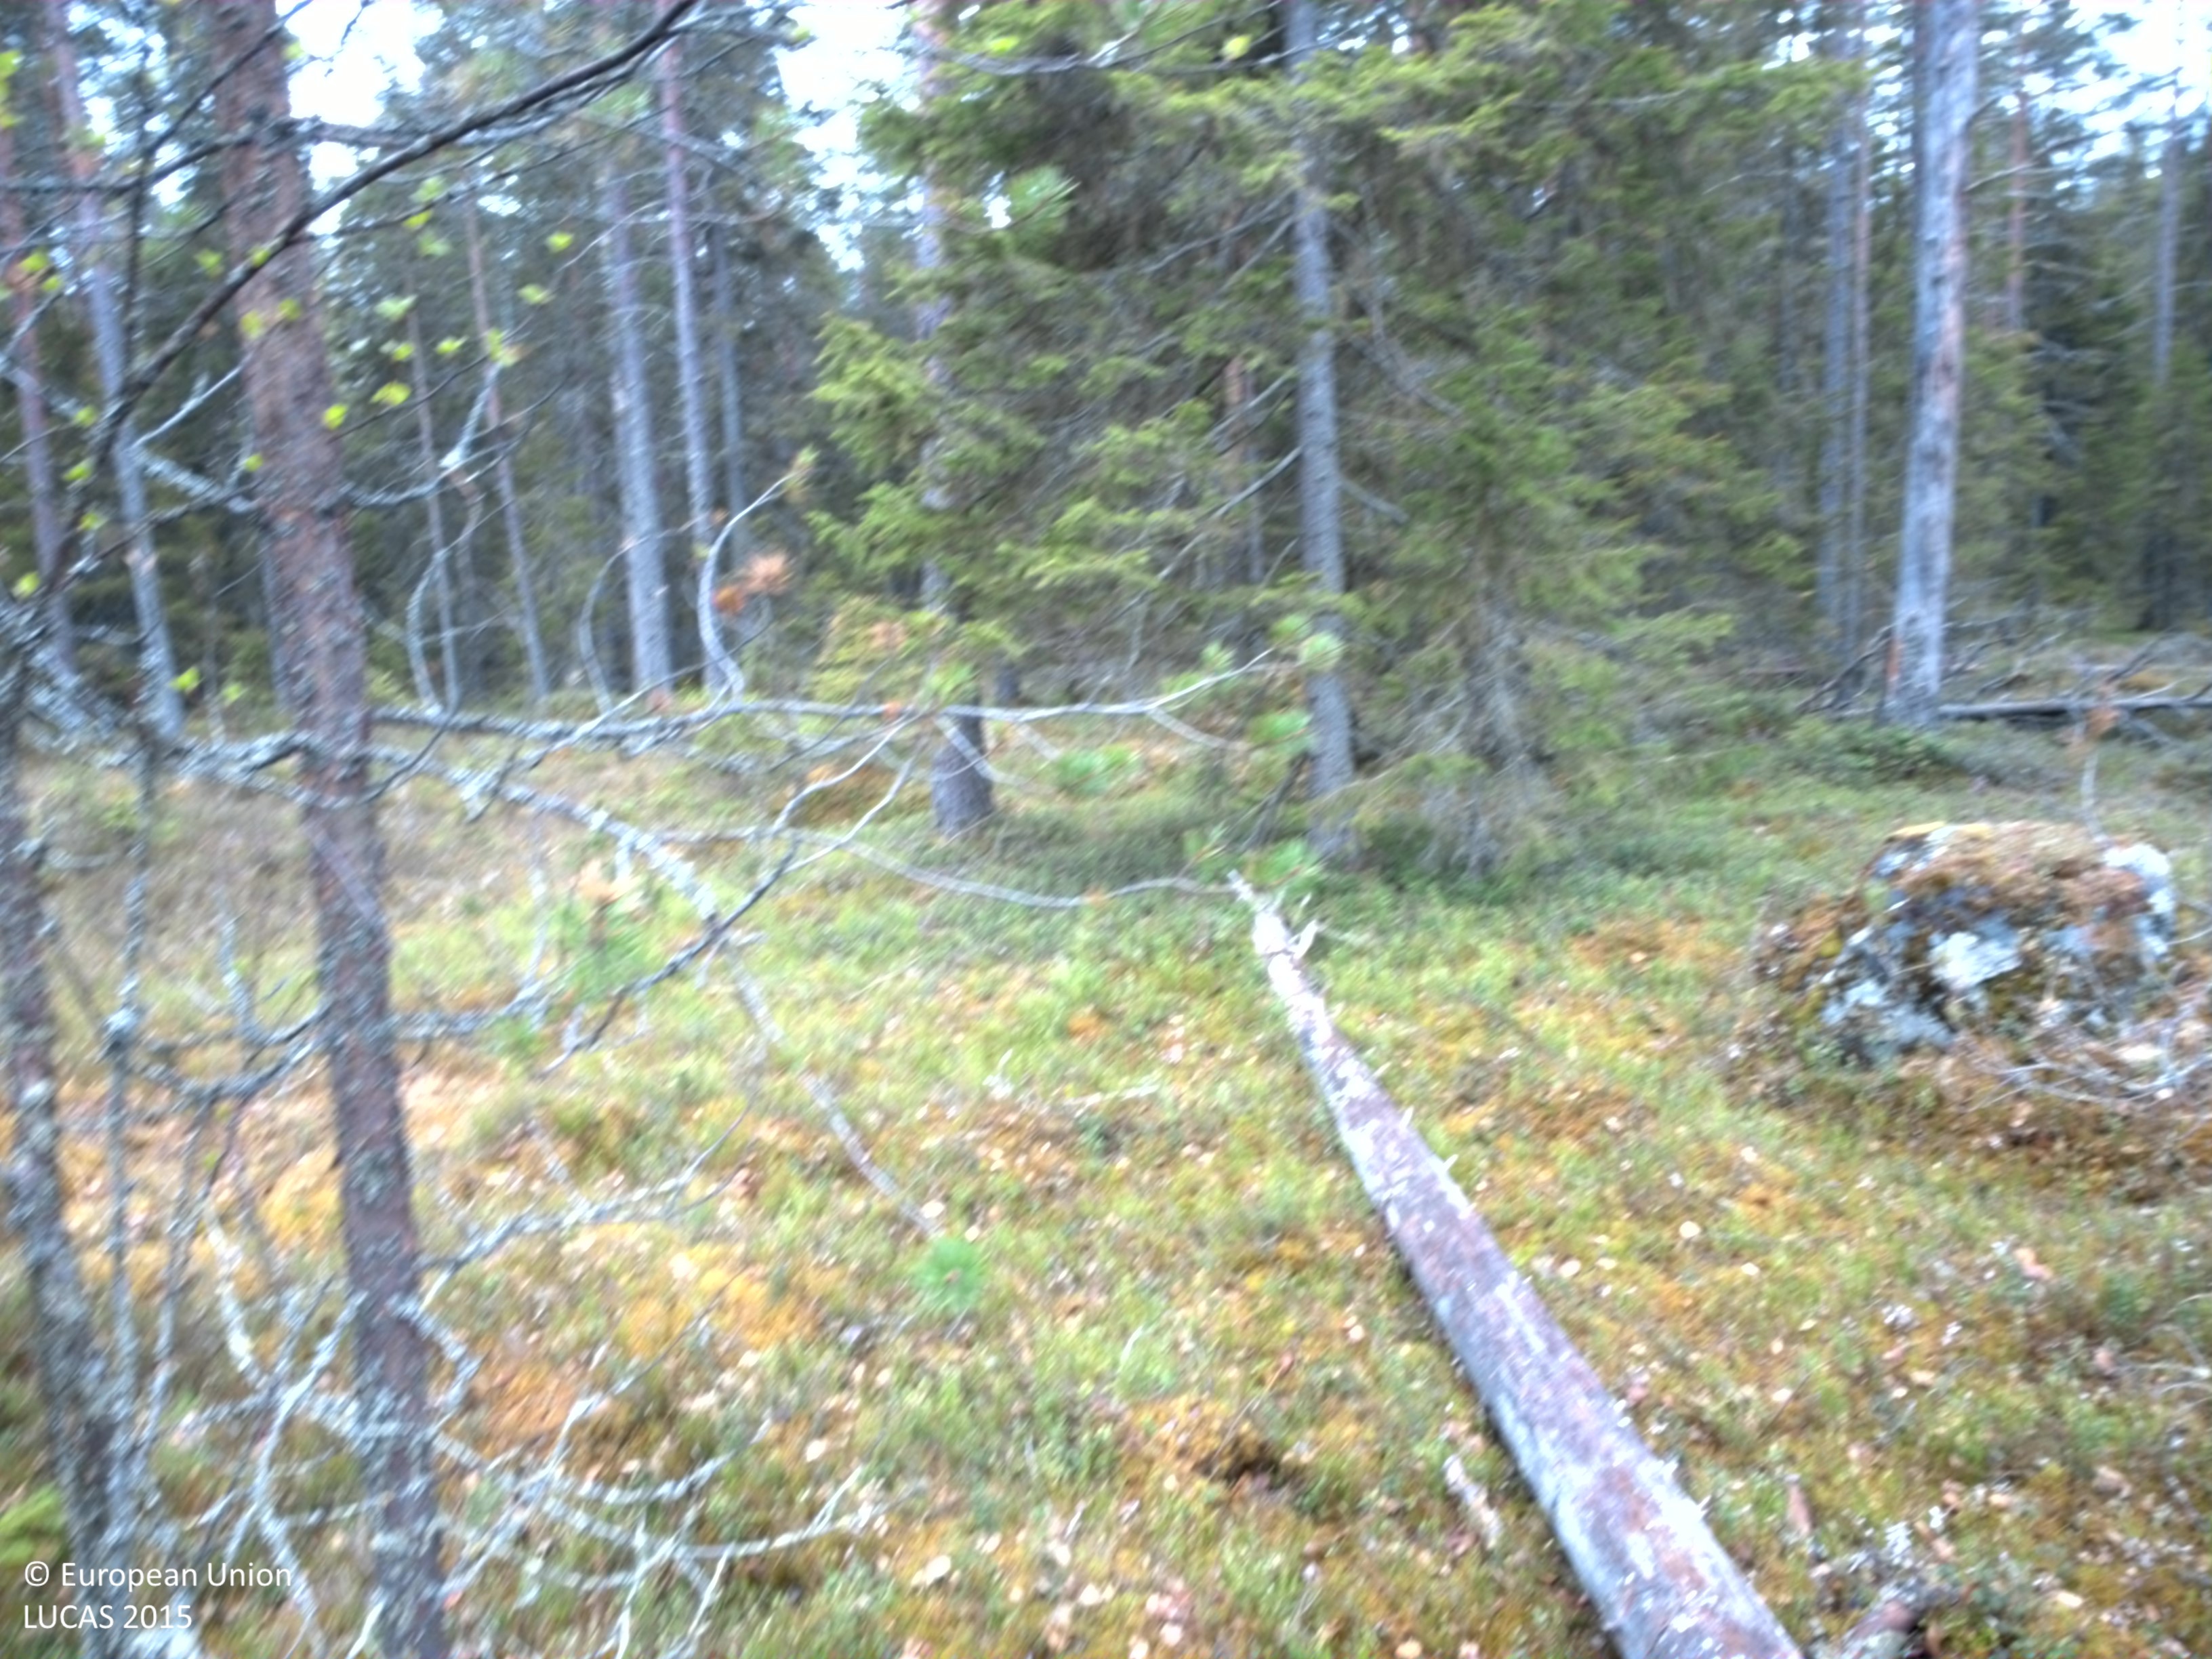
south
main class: Woodland
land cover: Pine dominated coniferous woodland
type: boreal forest
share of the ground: 50 - 75 %
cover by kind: coniferous forest trees 70 %, shrubs 30 %
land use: Forestry
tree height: > 5 m
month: June
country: SE
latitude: 65.8933
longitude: 23.0859
